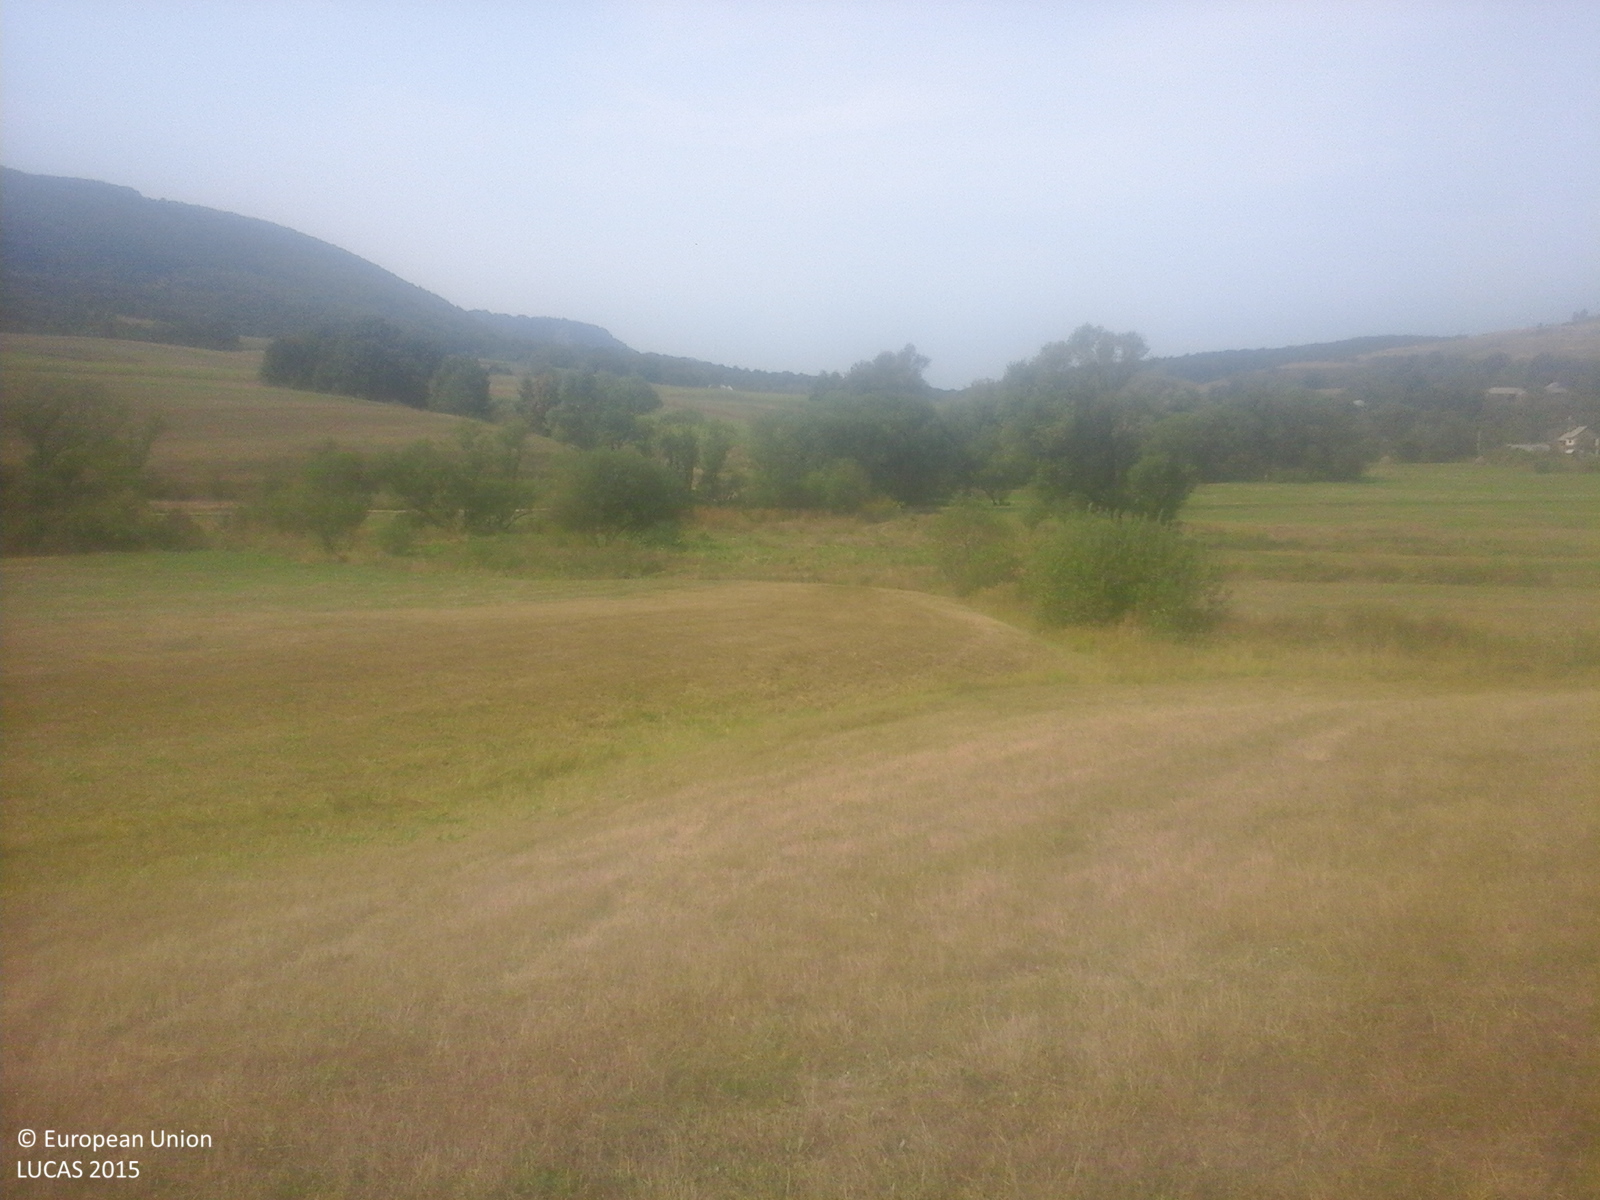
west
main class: Grassland
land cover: Grassland without tree/shrub cover
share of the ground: > 75 %
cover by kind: herbaceous plants 100 %
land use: Agriculture (excluding fallow land and kitchen gardens)
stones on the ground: < 10 %
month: September
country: RO
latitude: 47.4765
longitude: 23.8132
